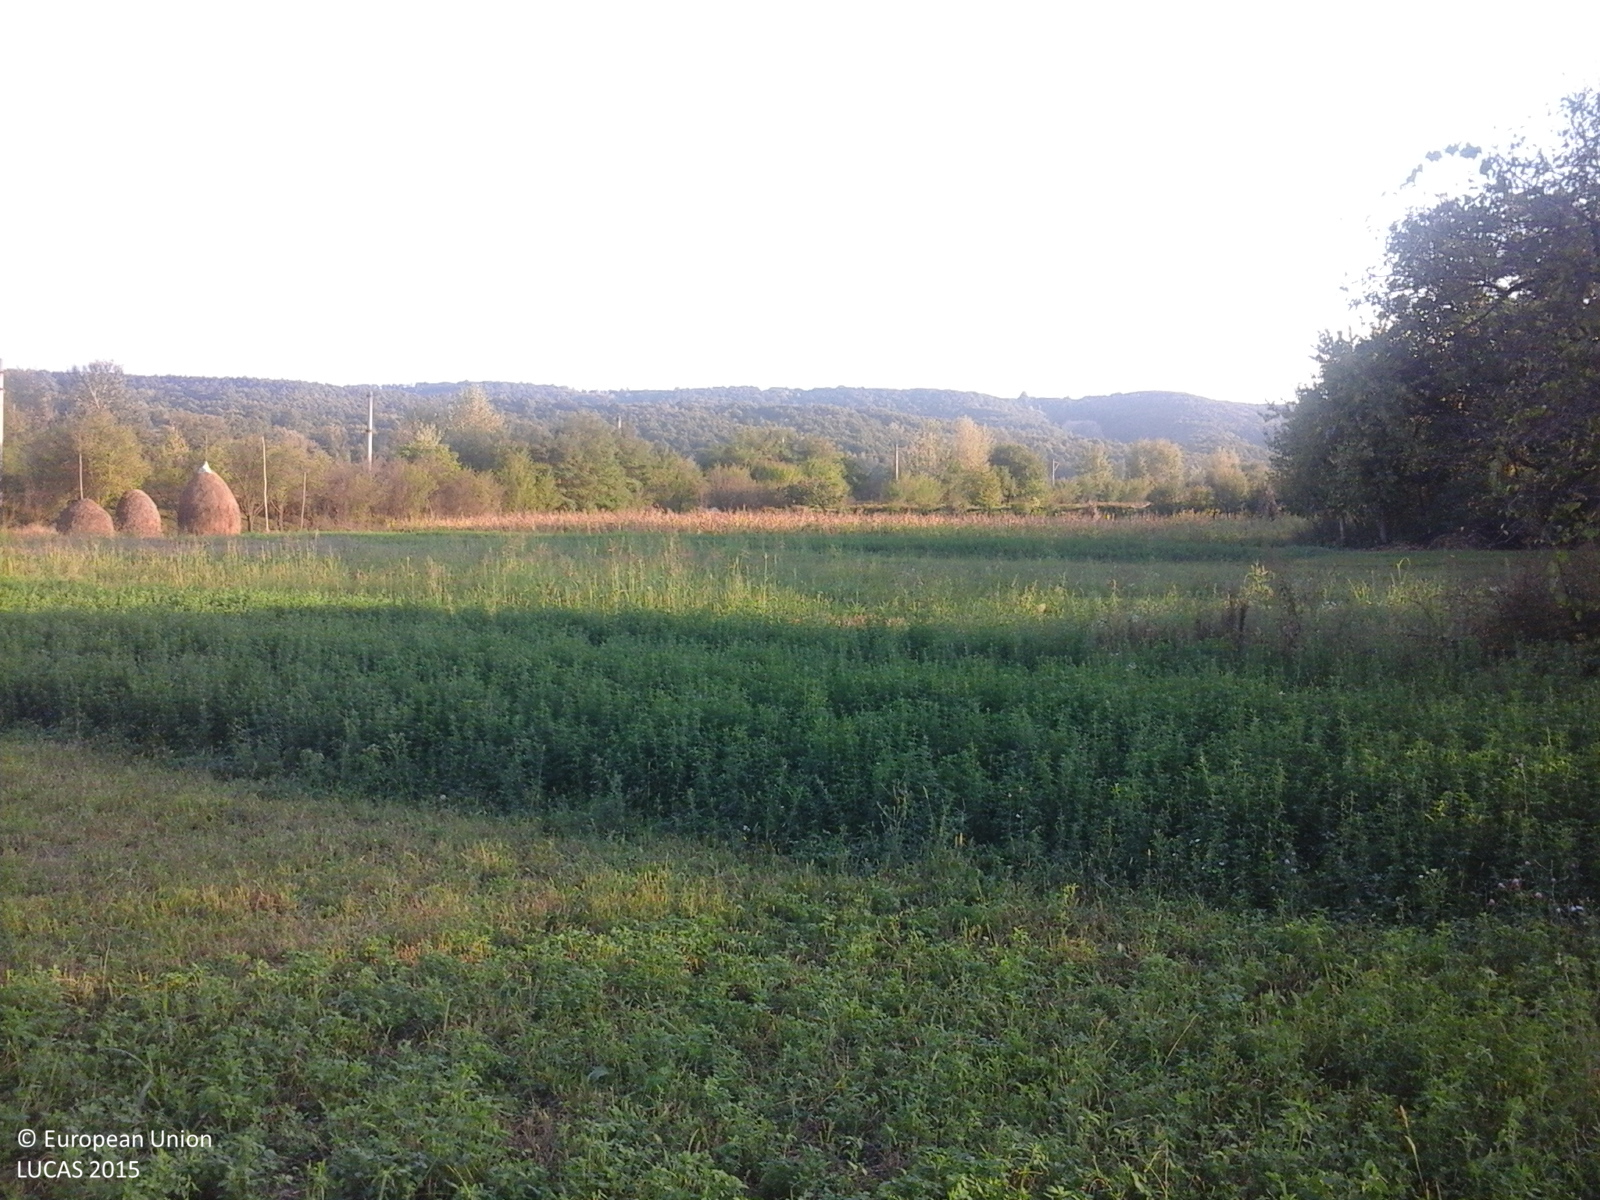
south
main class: Cropland
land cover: Lucerne
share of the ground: > 75 %
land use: Agriculture (excluding fallow land and kitchen gardens)
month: September
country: RO
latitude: 45.0213
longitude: 23.6000
